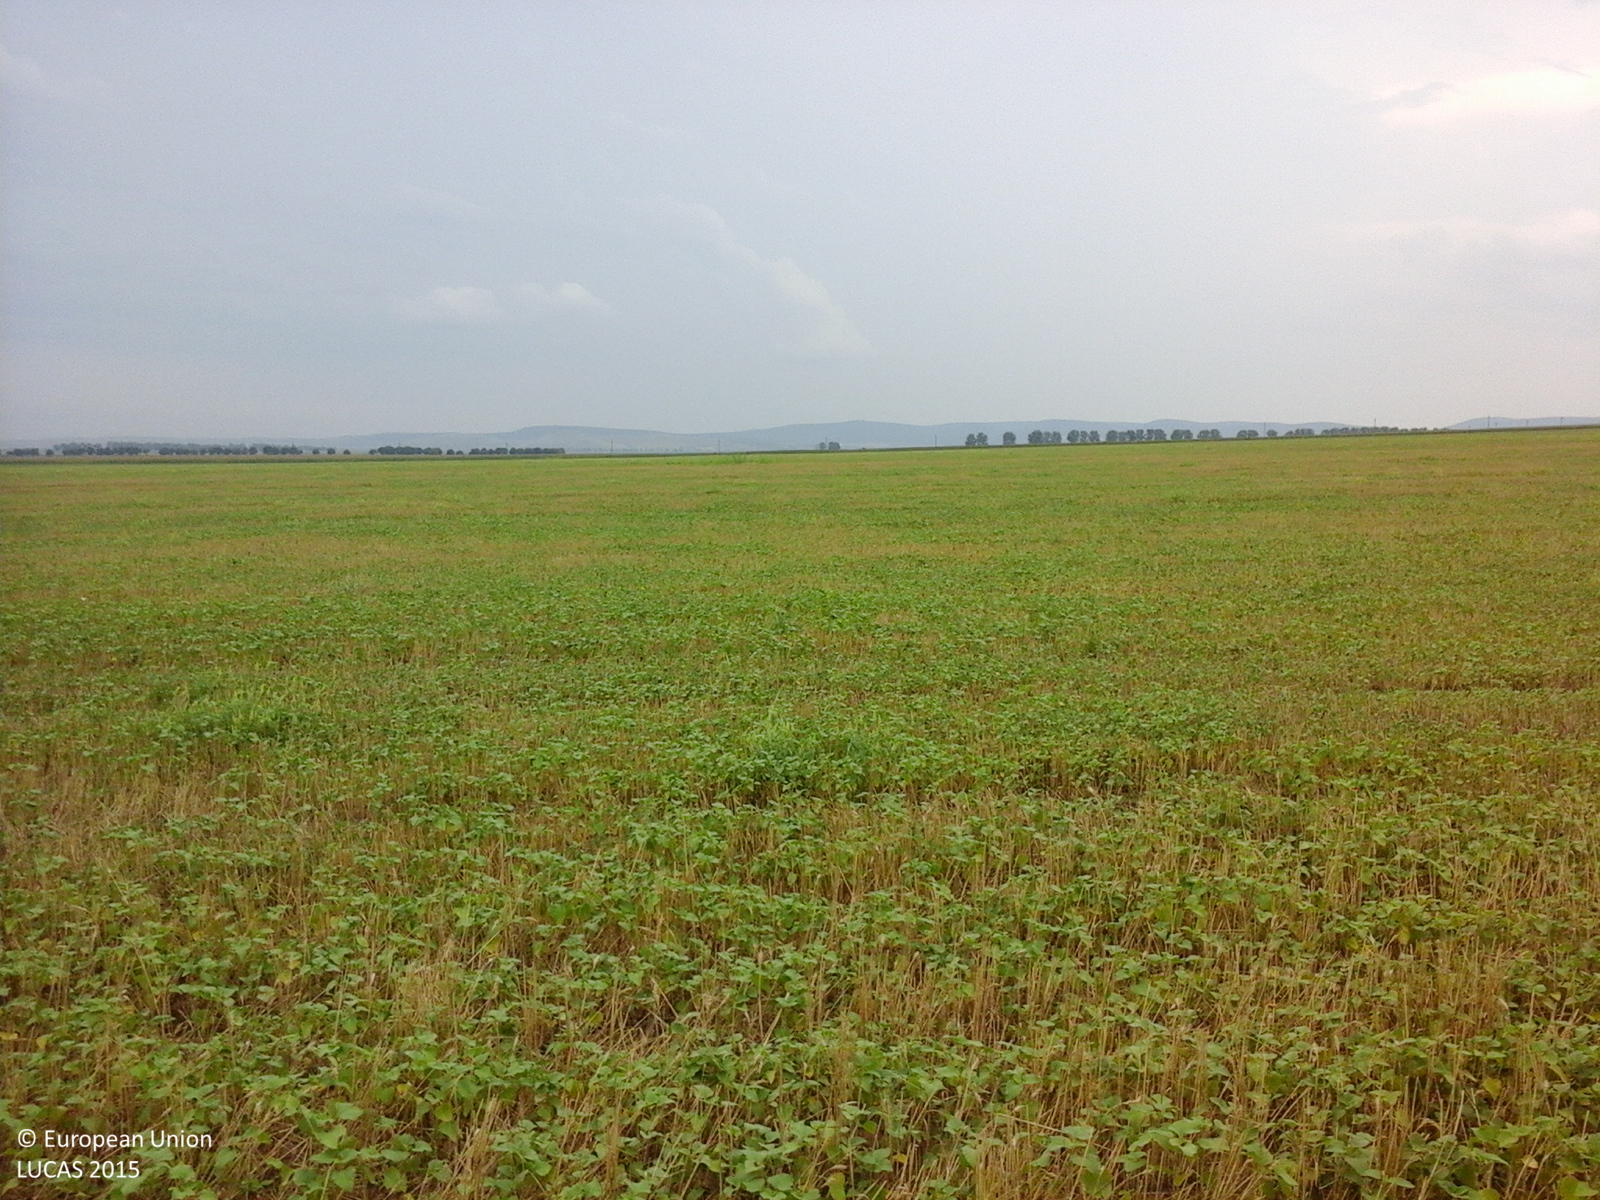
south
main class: Cropland
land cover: Common wheat
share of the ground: > 75 %
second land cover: Spontaneously vegetated surfaces
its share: 50 - 75 %
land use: Agriculture (excluding fallow land and kitchen gardens)
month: July
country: RO
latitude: 44.9579
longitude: 28.8115
